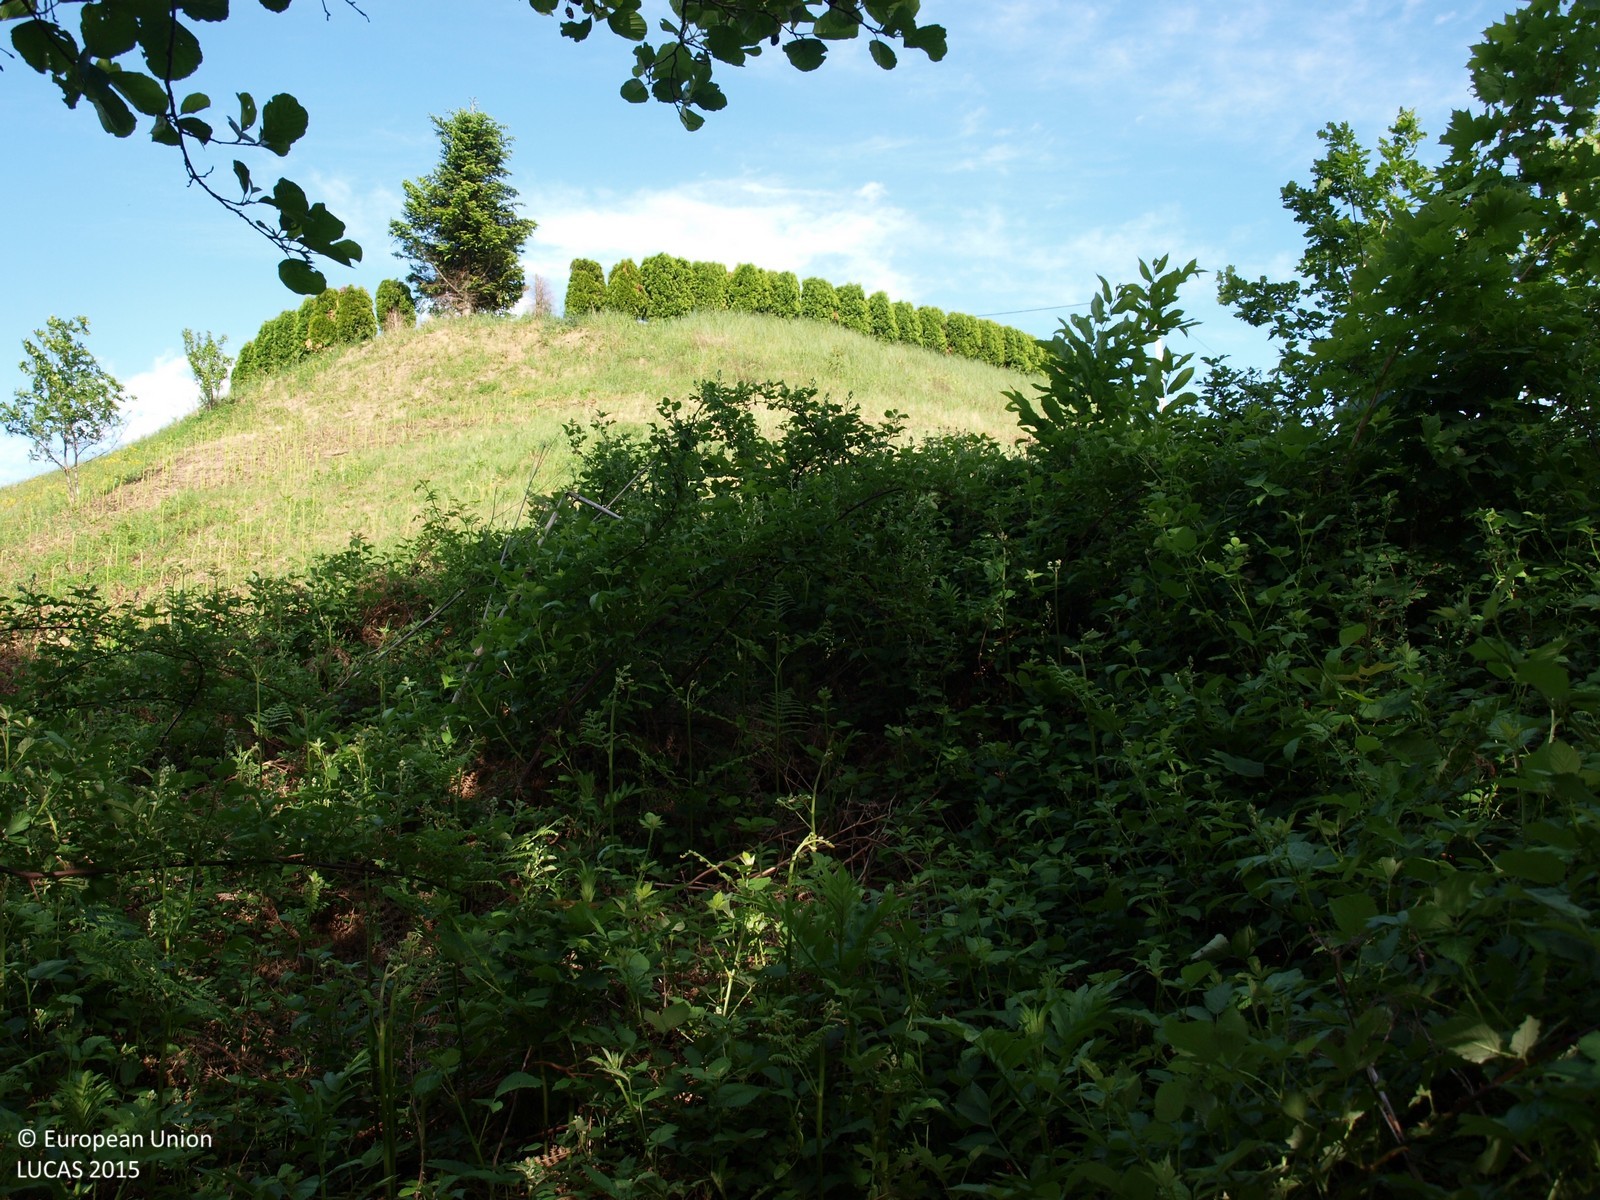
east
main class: Woodland
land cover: Broadleaved woodland
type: mesophytic deciduous forest
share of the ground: > 75 %
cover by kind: broadleaved forest trees 60 %, shrubs 30 %, herbaceous plants 10 %
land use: Forestry
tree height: > 5 m
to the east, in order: Broadleaved woodland; Grassland without tree/shrub cover; Conifer hedges; Grassland without tree/shrub cover; Electric lines; Paved roads, cycling and walking lanes; Vineyards; Grassland without tree/shrub cover; Tracks; Grassland without tree/shrub cover; Single bushes/trees; Grassland without tree/shrub cover; Maize; Grass margins; Maize
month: May
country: HR
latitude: 46.2246
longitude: 15.8979
